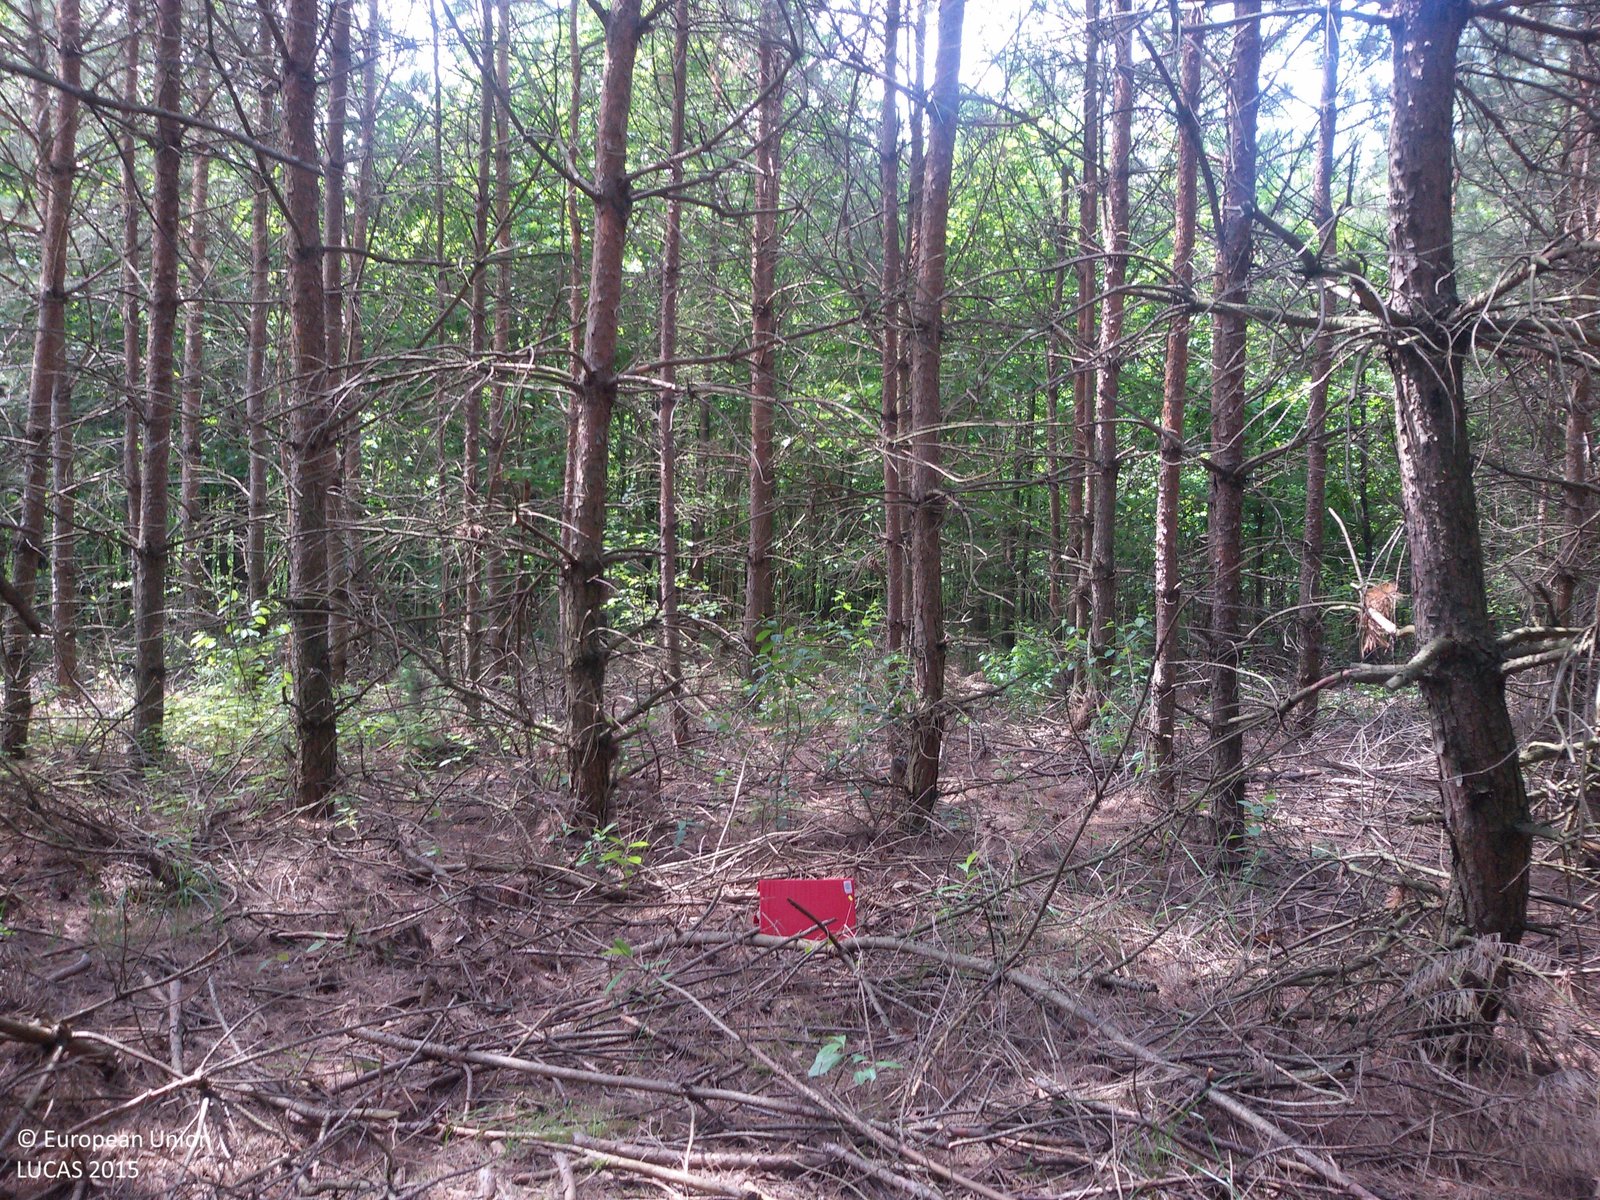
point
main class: Woodland
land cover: Pine dominated coniferous woodland
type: hemiboreal forest and nemoral coniferous forest and mixed broadleaved-coniferous forest
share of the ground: > 75 %
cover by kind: coniferous forest trees 90 %, broadleaved forest trees 5 %, shrubs 5 %
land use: Forestry
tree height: > 5 m
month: June
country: PL
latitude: 51.5174
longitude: 22.7964
